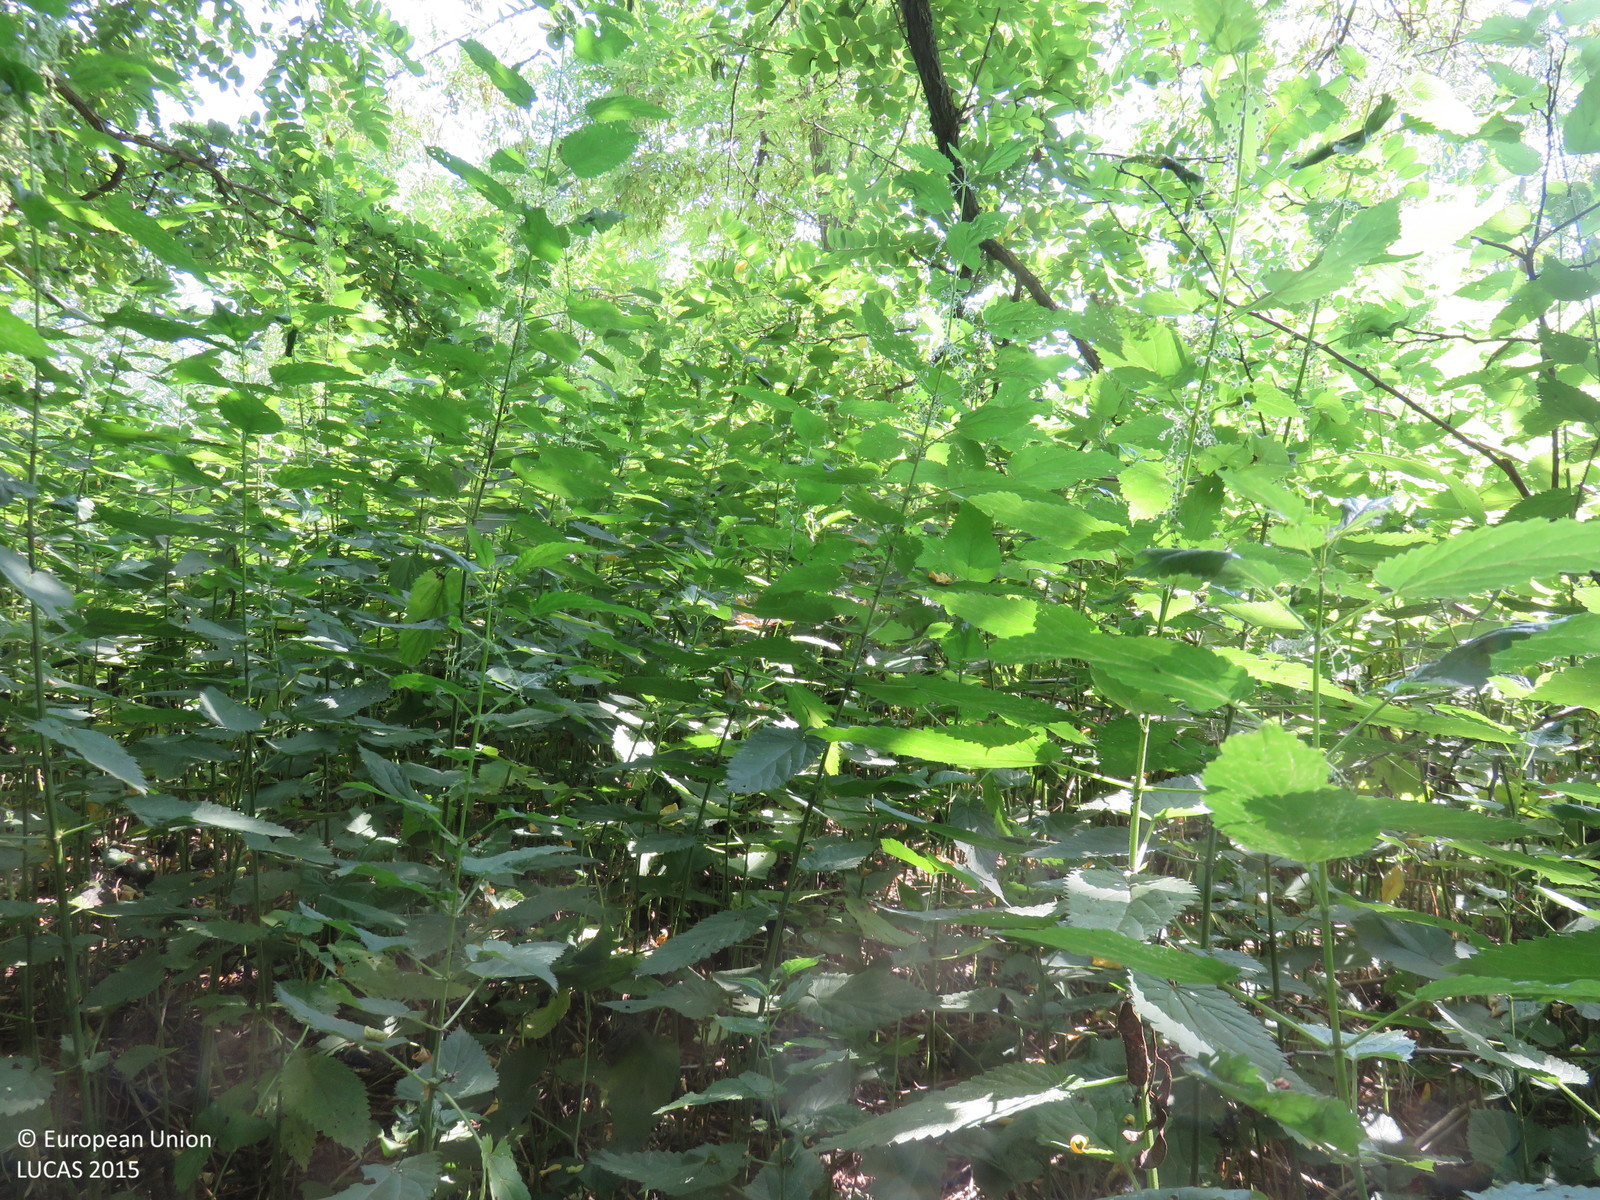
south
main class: Woodland
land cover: Broadleaved woodland
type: mesophytic deciduous forest
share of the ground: > 75 %
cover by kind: broadleaved forest trees 85 %, herbaceous plants 10 %, shrubs 5 %
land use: Forestry
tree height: < 5 m
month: July
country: BG
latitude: 43.5906
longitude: 24.9467
